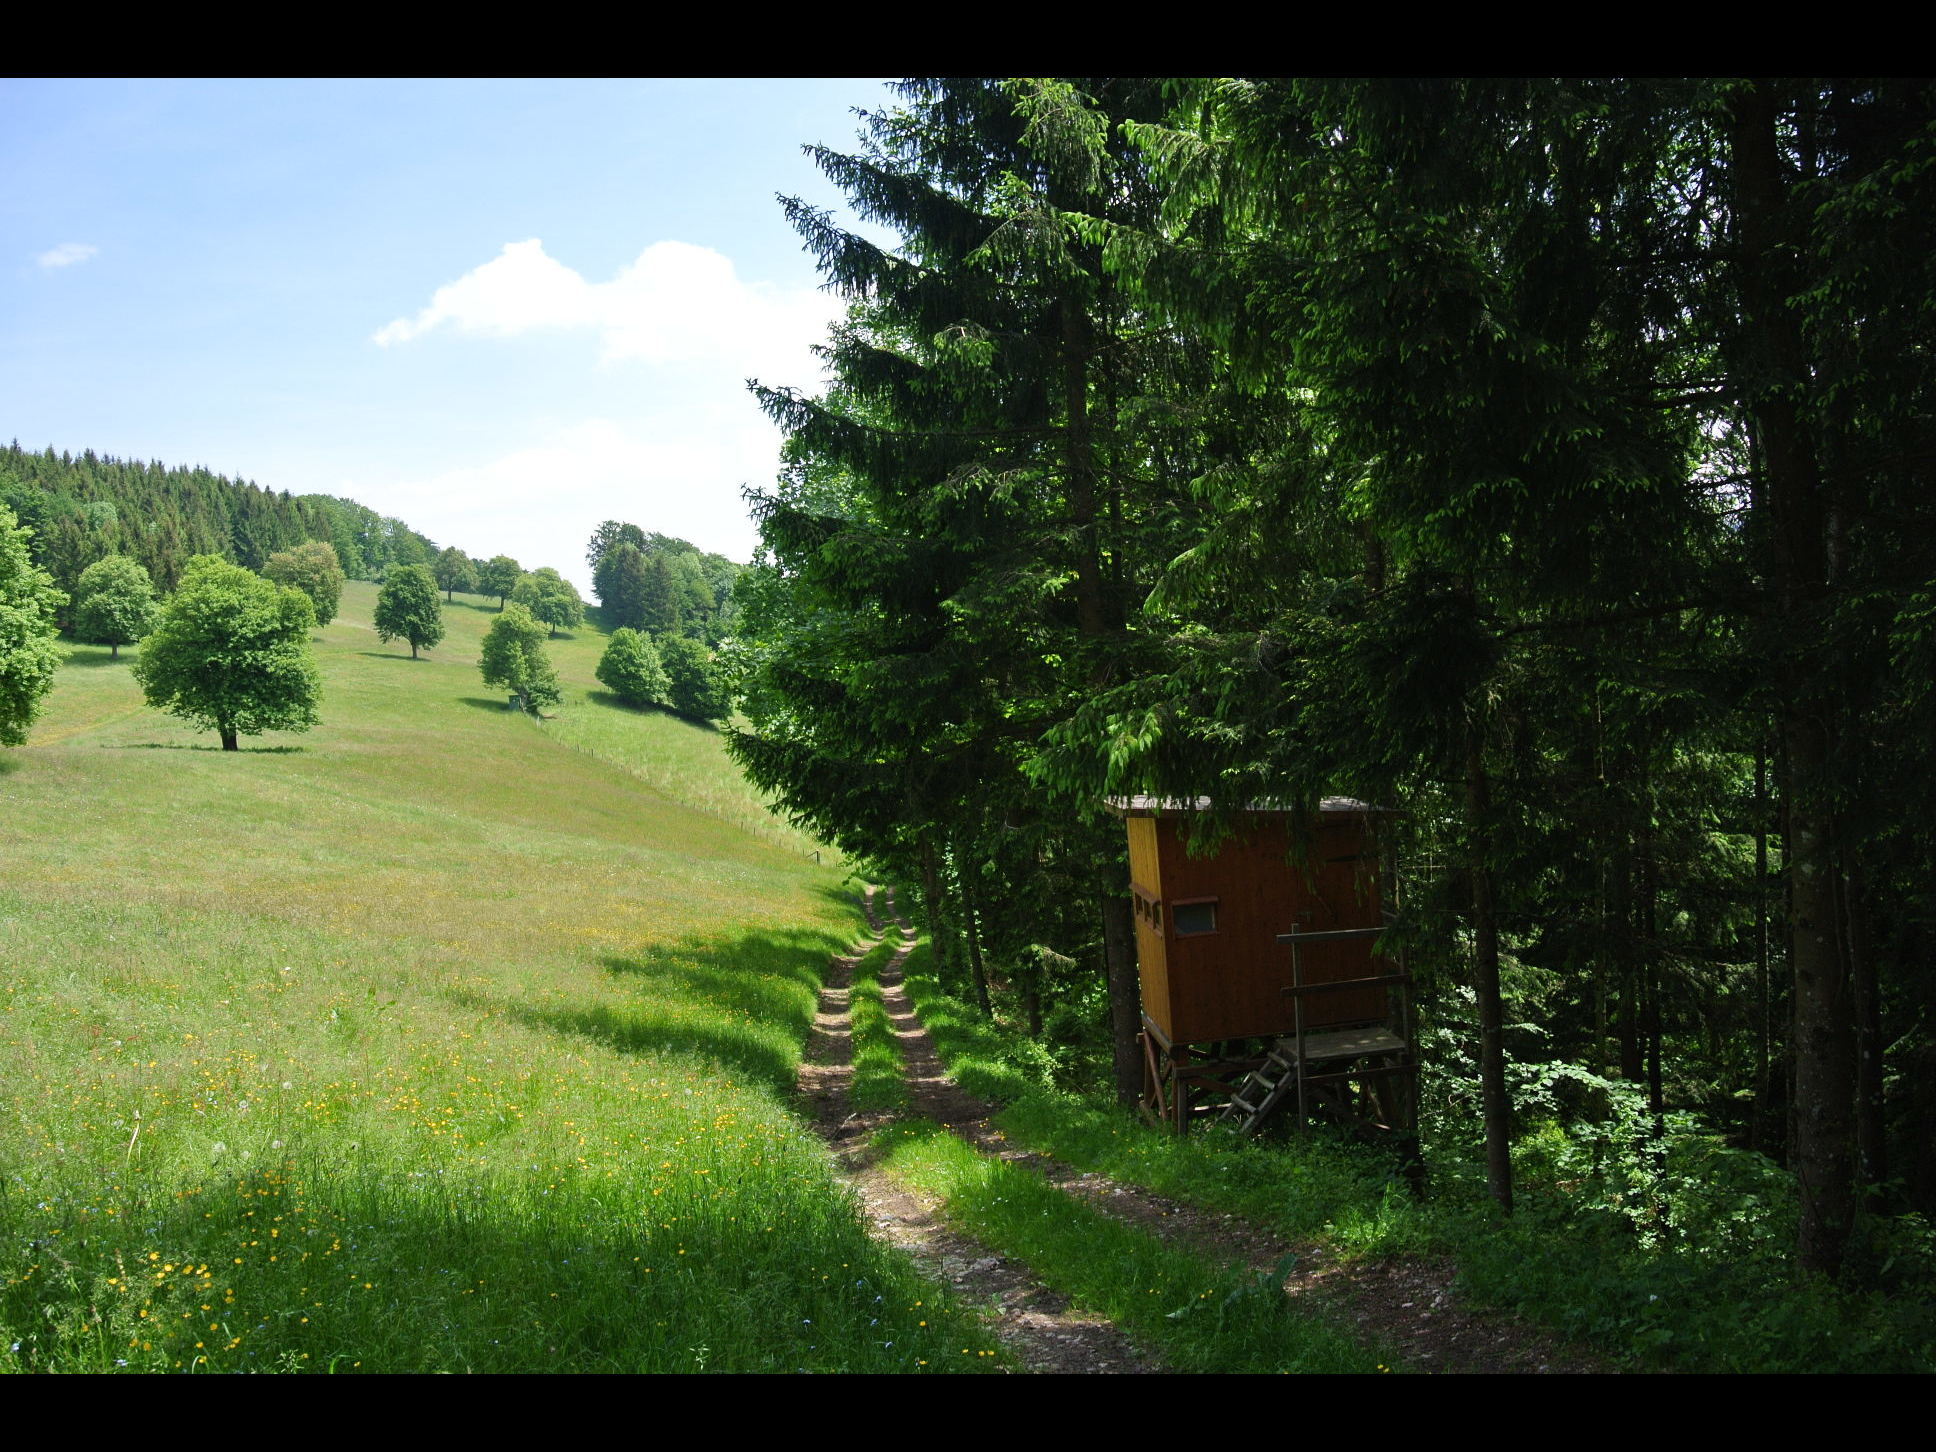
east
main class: Grassland
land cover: Grassland without tree/shrub cover
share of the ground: > 75 %
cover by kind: herbaceous plants 100 %
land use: Agriculture (excluding fallow land and kitchen gardens)
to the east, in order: Grassland without tree/shrub cover; Tracks; Grassland without tree/shrub cover; Tracks; Fences; Grassland without tree/shrub cover; Tracks; Grassland without tree/shrub cover; Grassland with sparse tree/shrub cover; Grassland without tree/shrub cover
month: May
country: AT
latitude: 48.0163
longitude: 15.8079
